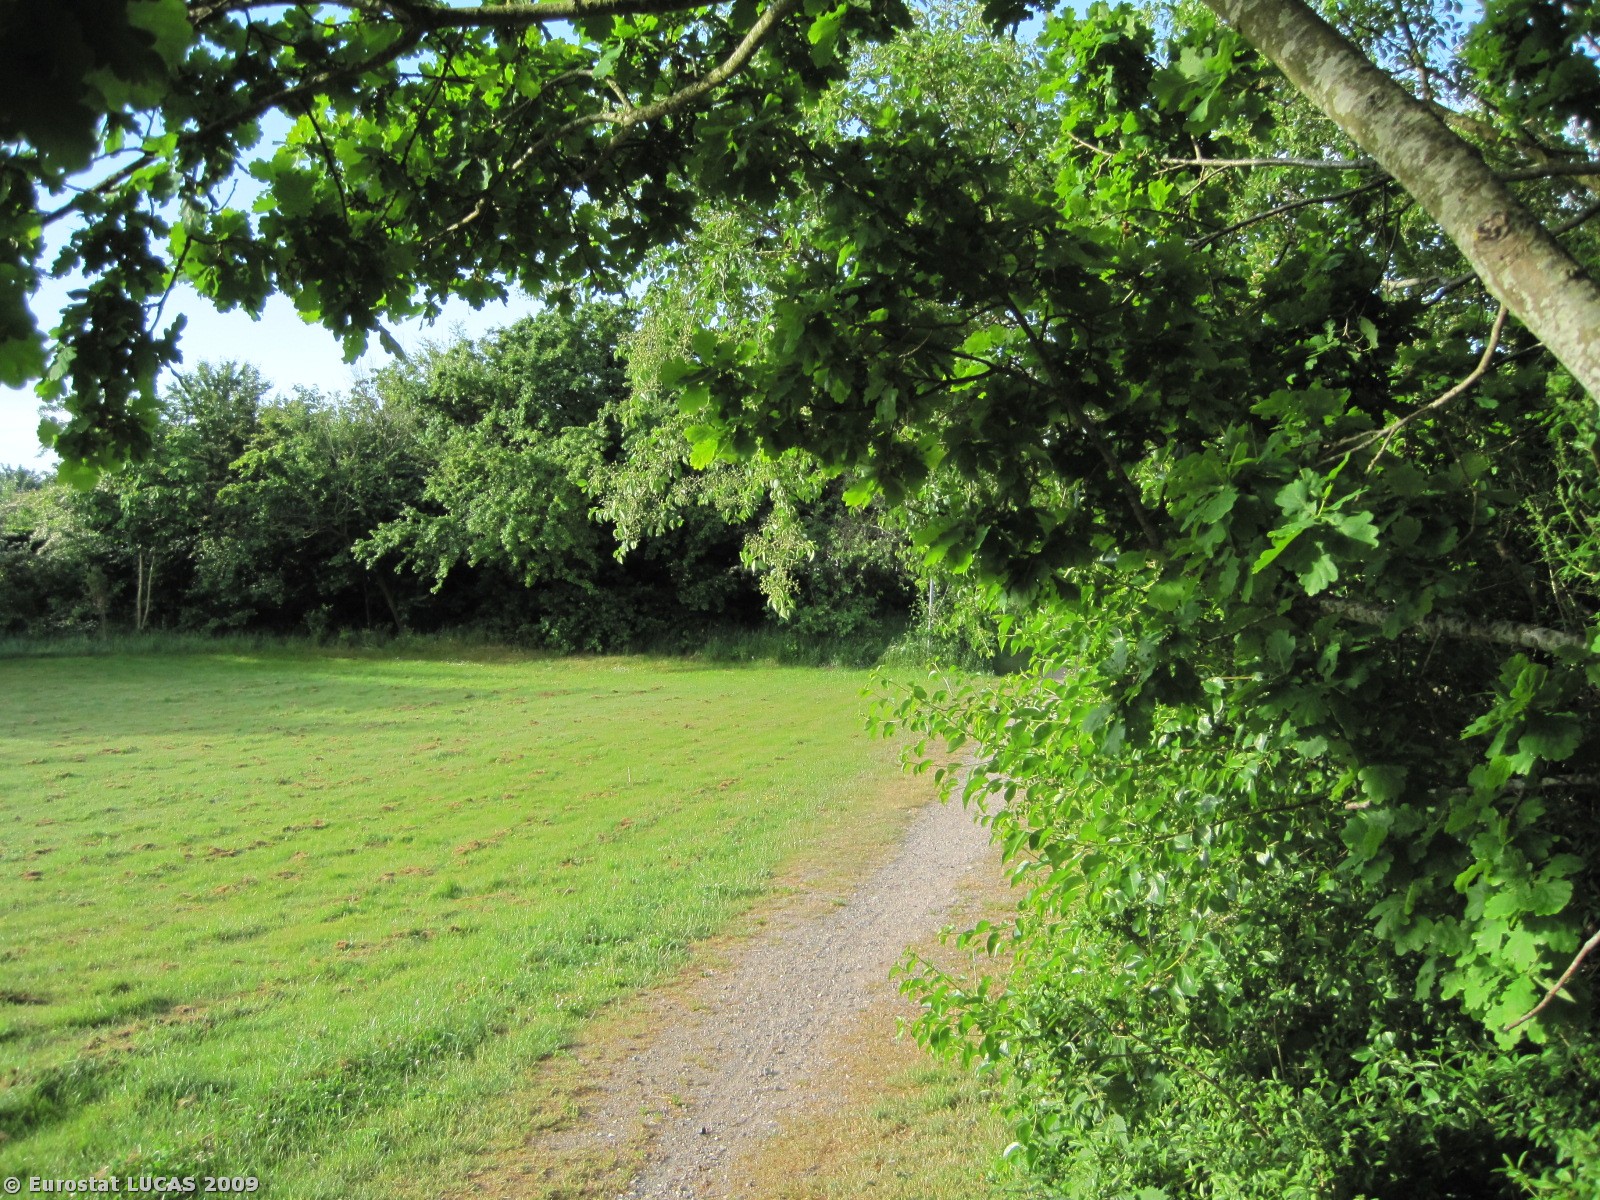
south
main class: Woodland
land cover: Broadleaved woodland
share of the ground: 50 - 75 %
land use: Amenities, museums, leisure
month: June
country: DK
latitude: 57.1046
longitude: 10.0824
